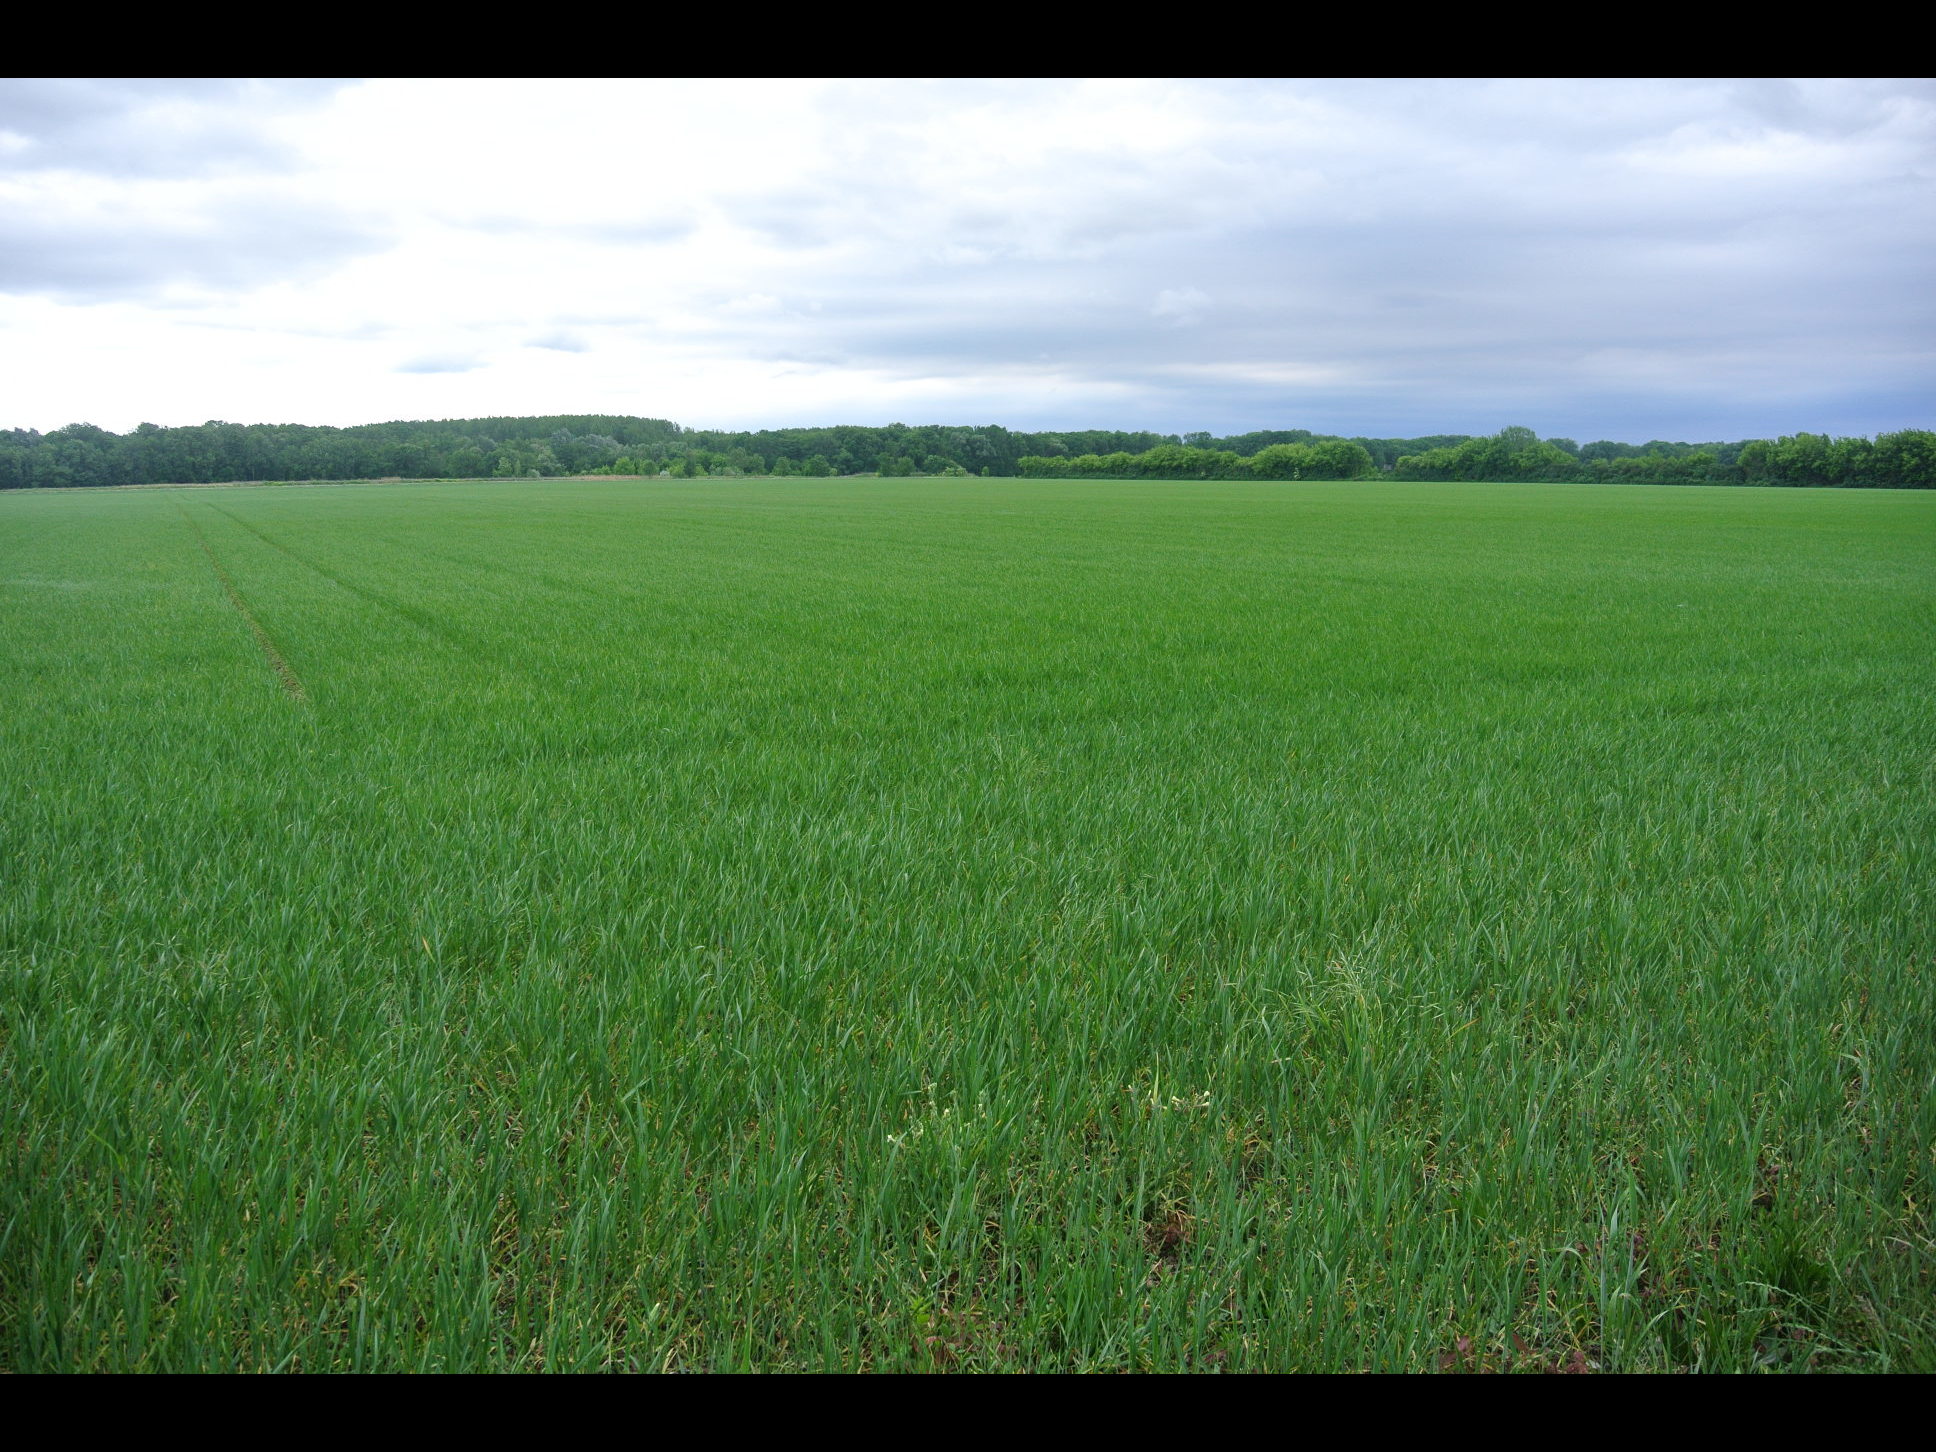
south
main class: Woodland
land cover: Broadleaved woodland
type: beech forest
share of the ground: > 75 %
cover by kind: broadleaved forest trees 100 %
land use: Semi-natural and natural areas not in use
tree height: > 5 m
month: May
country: AT
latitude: 48.0247
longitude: 16.6162
